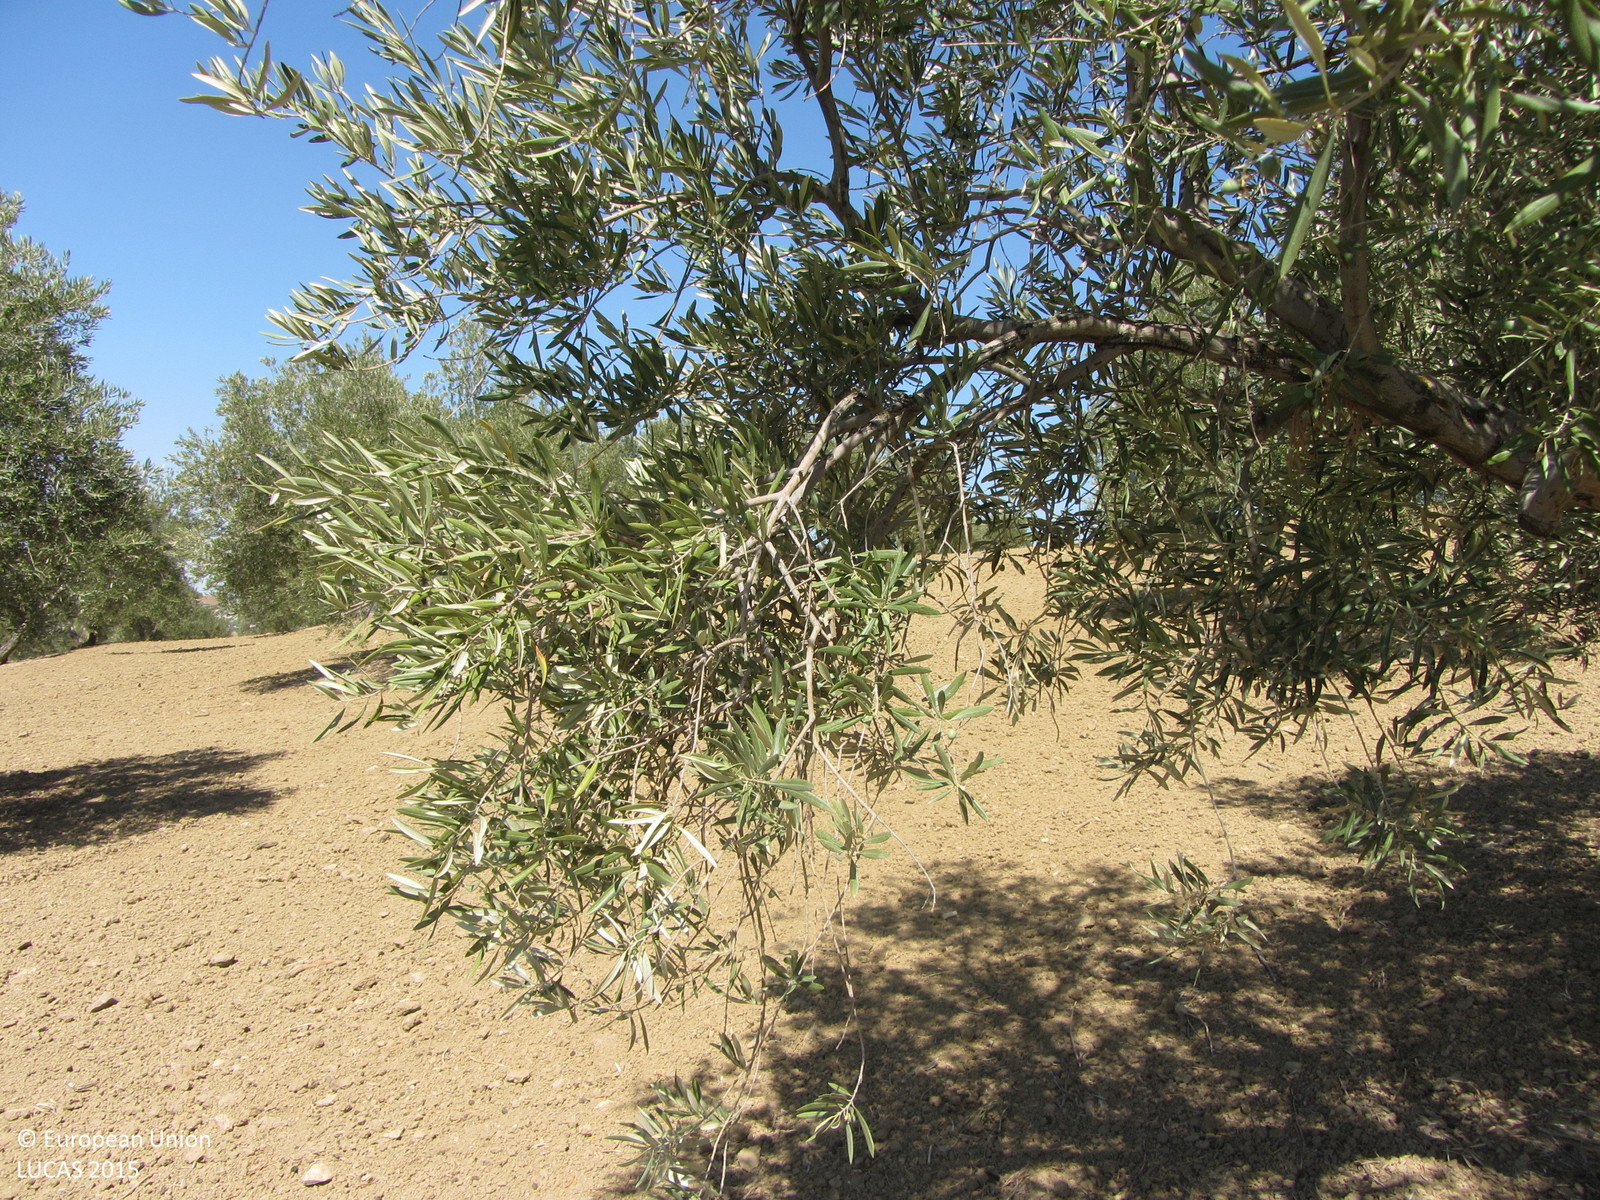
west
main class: Cropland
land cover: Olive groves
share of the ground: 25 - 50 %
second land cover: Other bare soil
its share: > 75 %
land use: Agriculture (excluding fallow land and kitchen gardens)
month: July
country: ES
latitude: 37.8838
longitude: -3.8632
